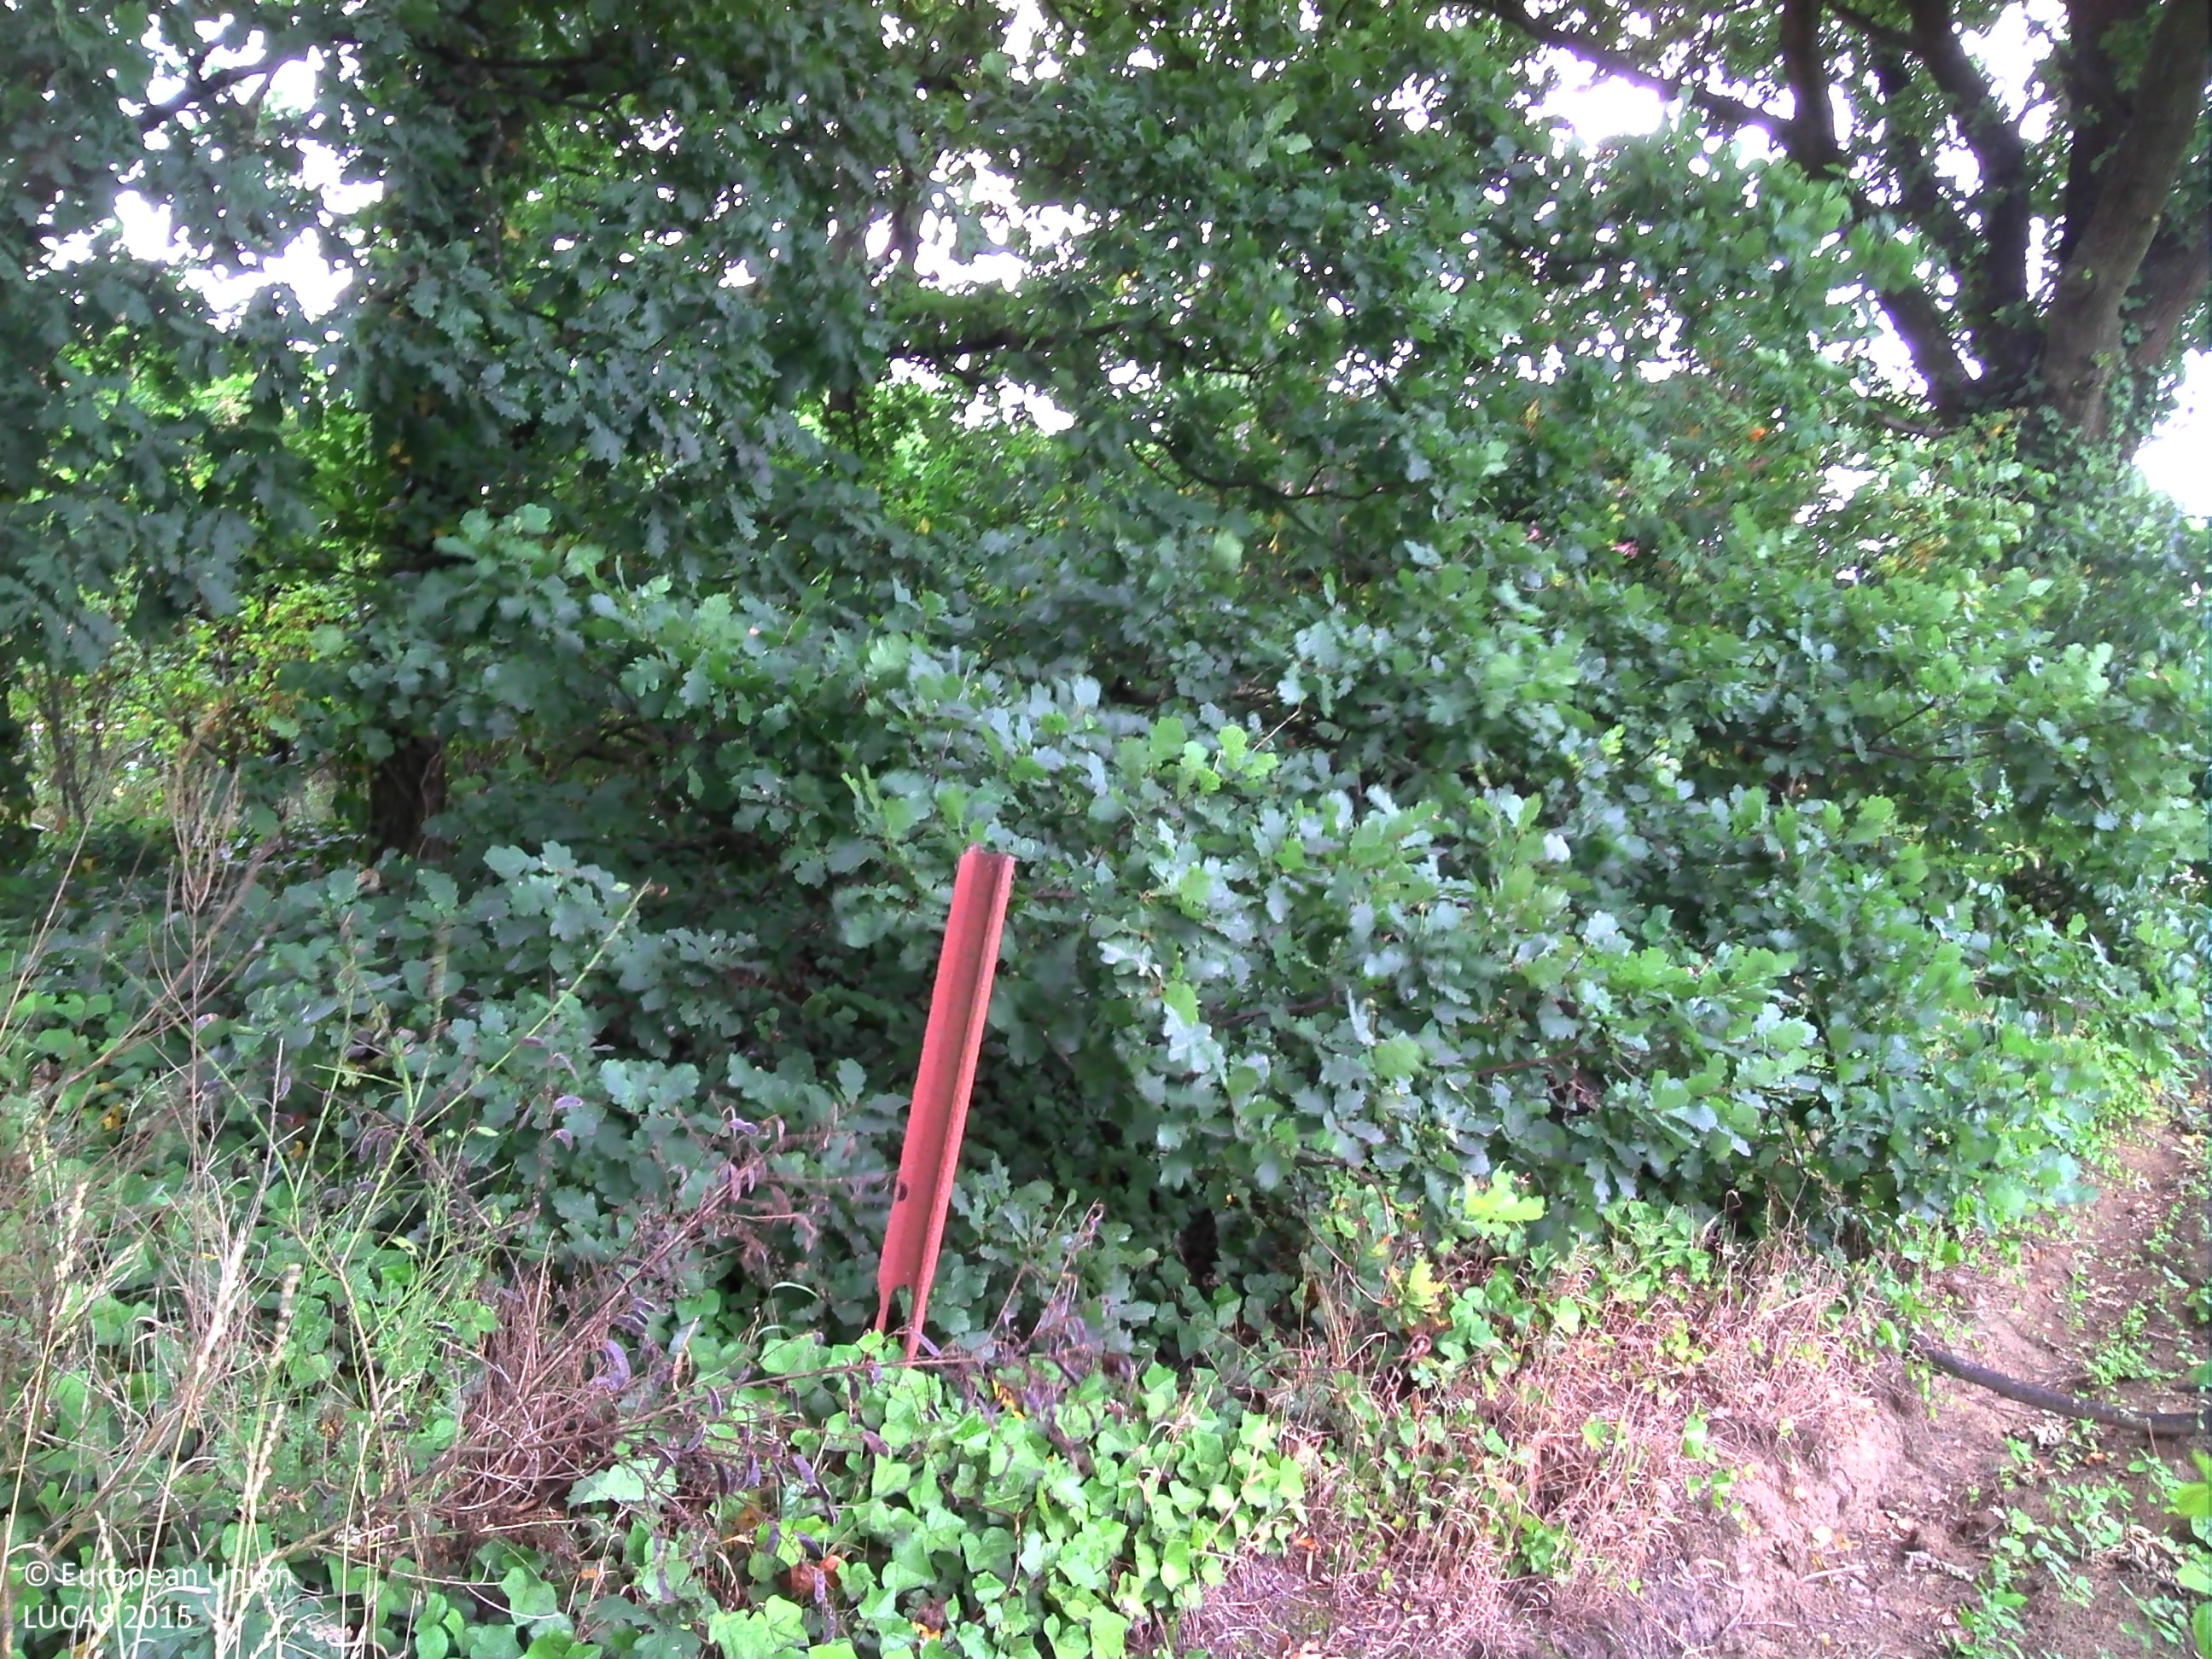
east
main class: Cropland
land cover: Potatoes
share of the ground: > 75 %
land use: Agriculture (excluding fallow land and kitchen gardens)
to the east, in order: Potatoes; Pine dominated mixed woodland; Artificial constructions in urban areas; Pine dominated coniferous woodland; Tracks; Grass margins; Maize
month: July
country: BE
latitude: 51.2104
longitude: 5.4603
